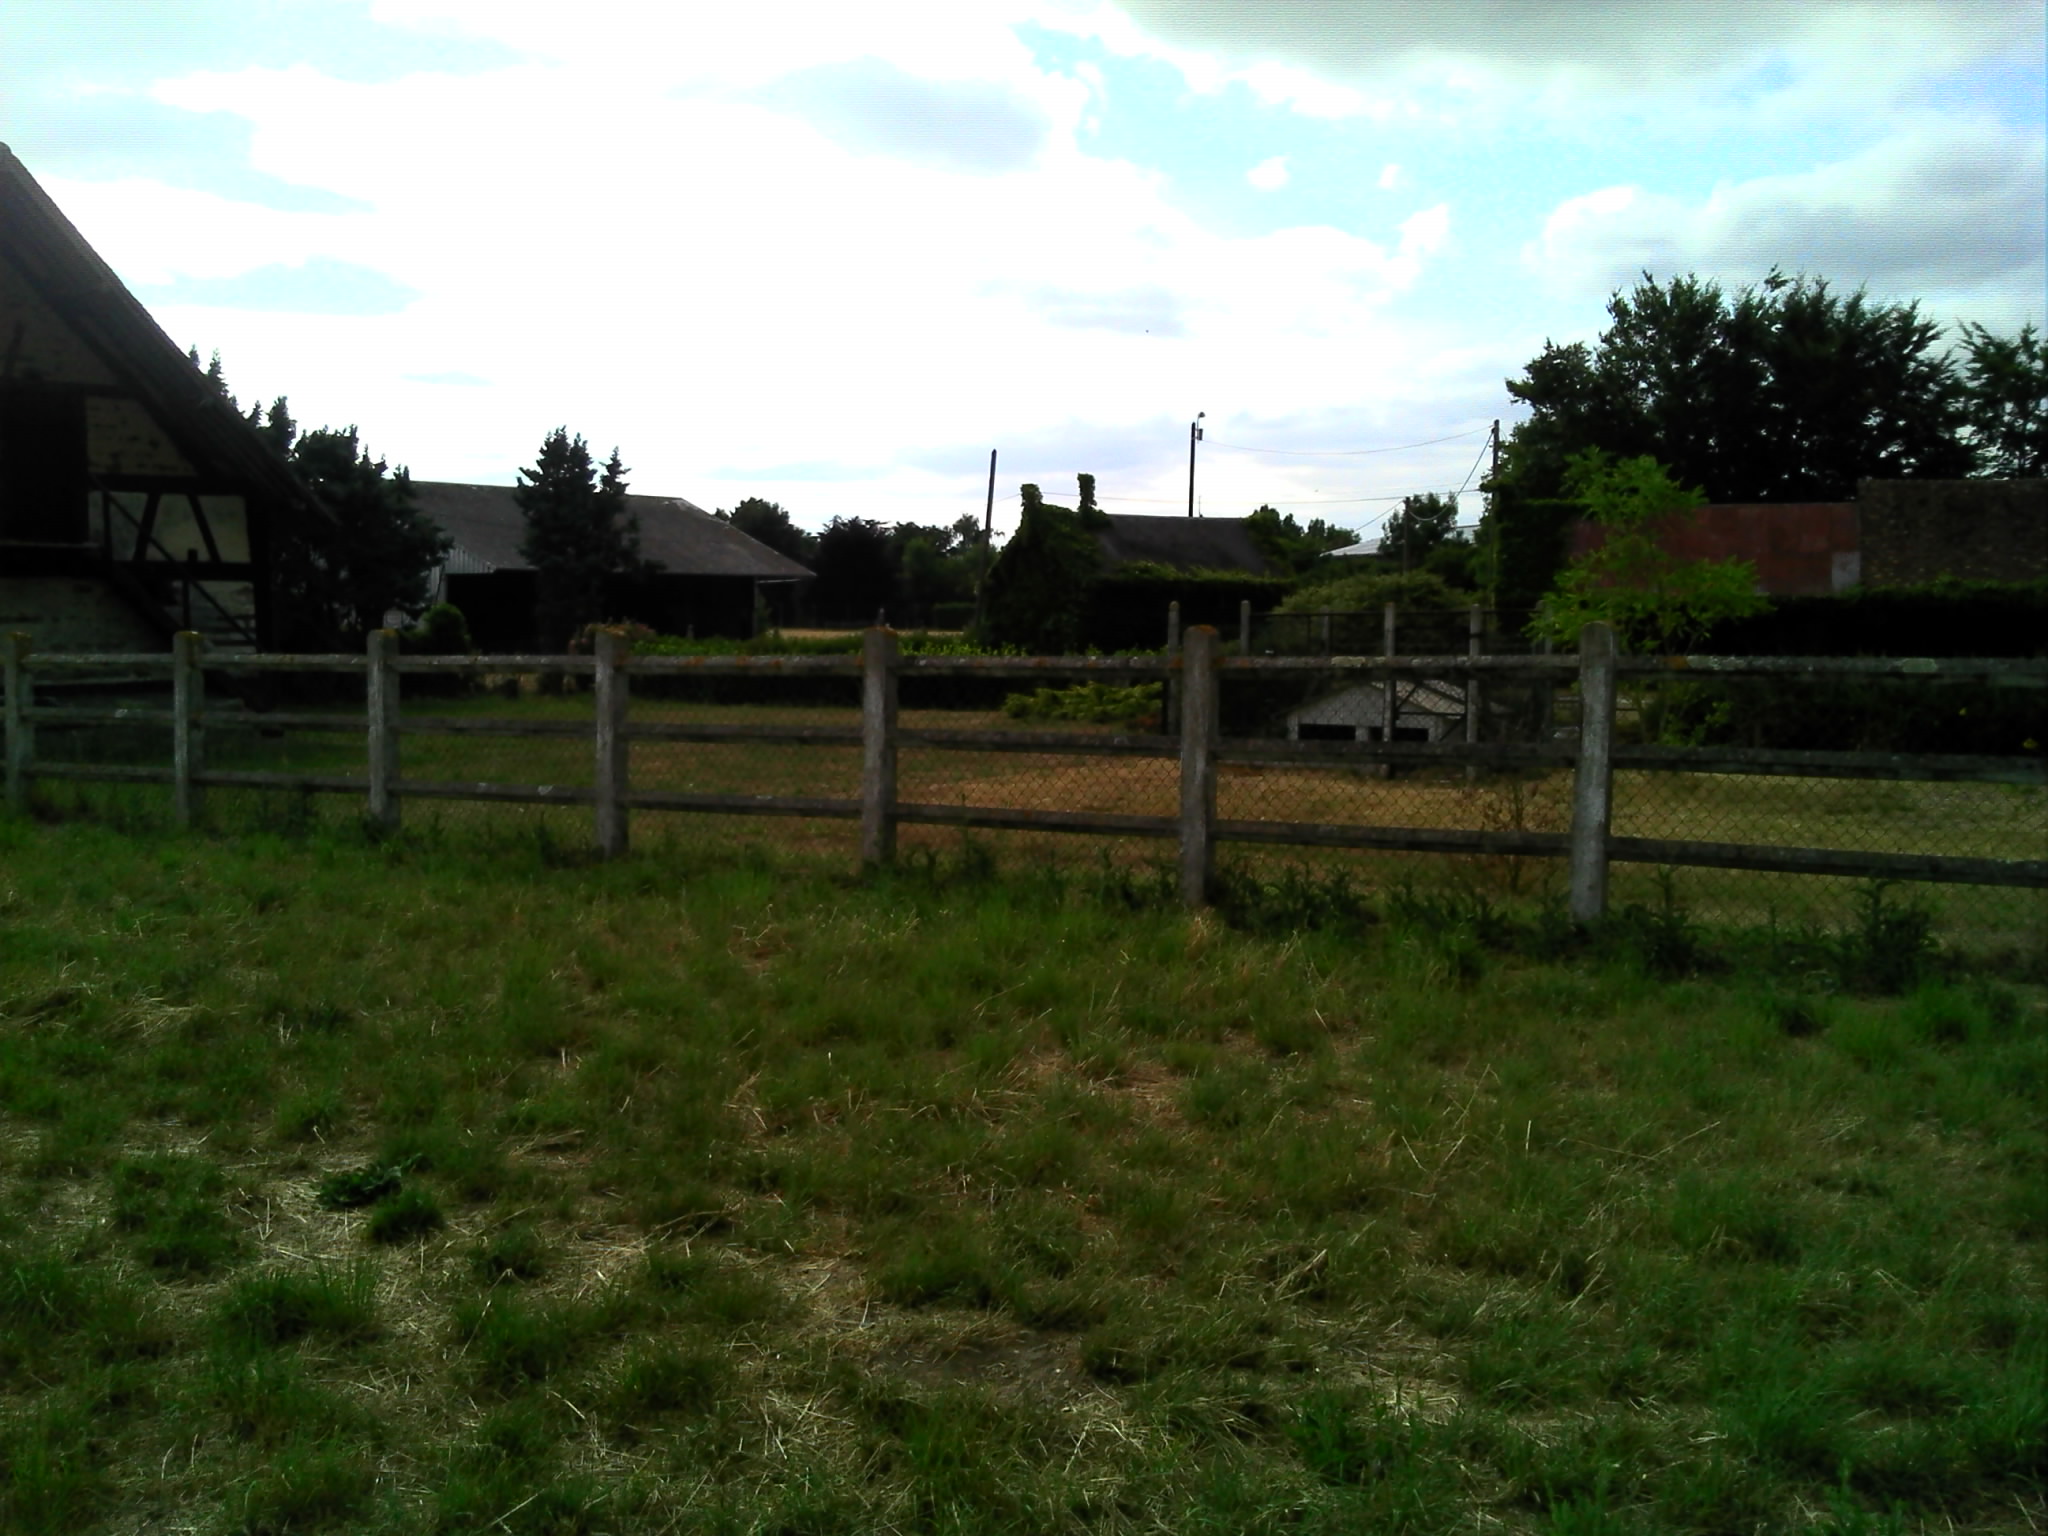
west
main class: Grassland
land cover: Grassland without tree/shrub cover
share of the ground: > 75 %
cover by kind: herbaceous plants 100 %
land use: Agriculture (excluding fallow land and kitchen gardens)
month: July
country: FR
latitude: 48.9325
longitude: 1.1204
